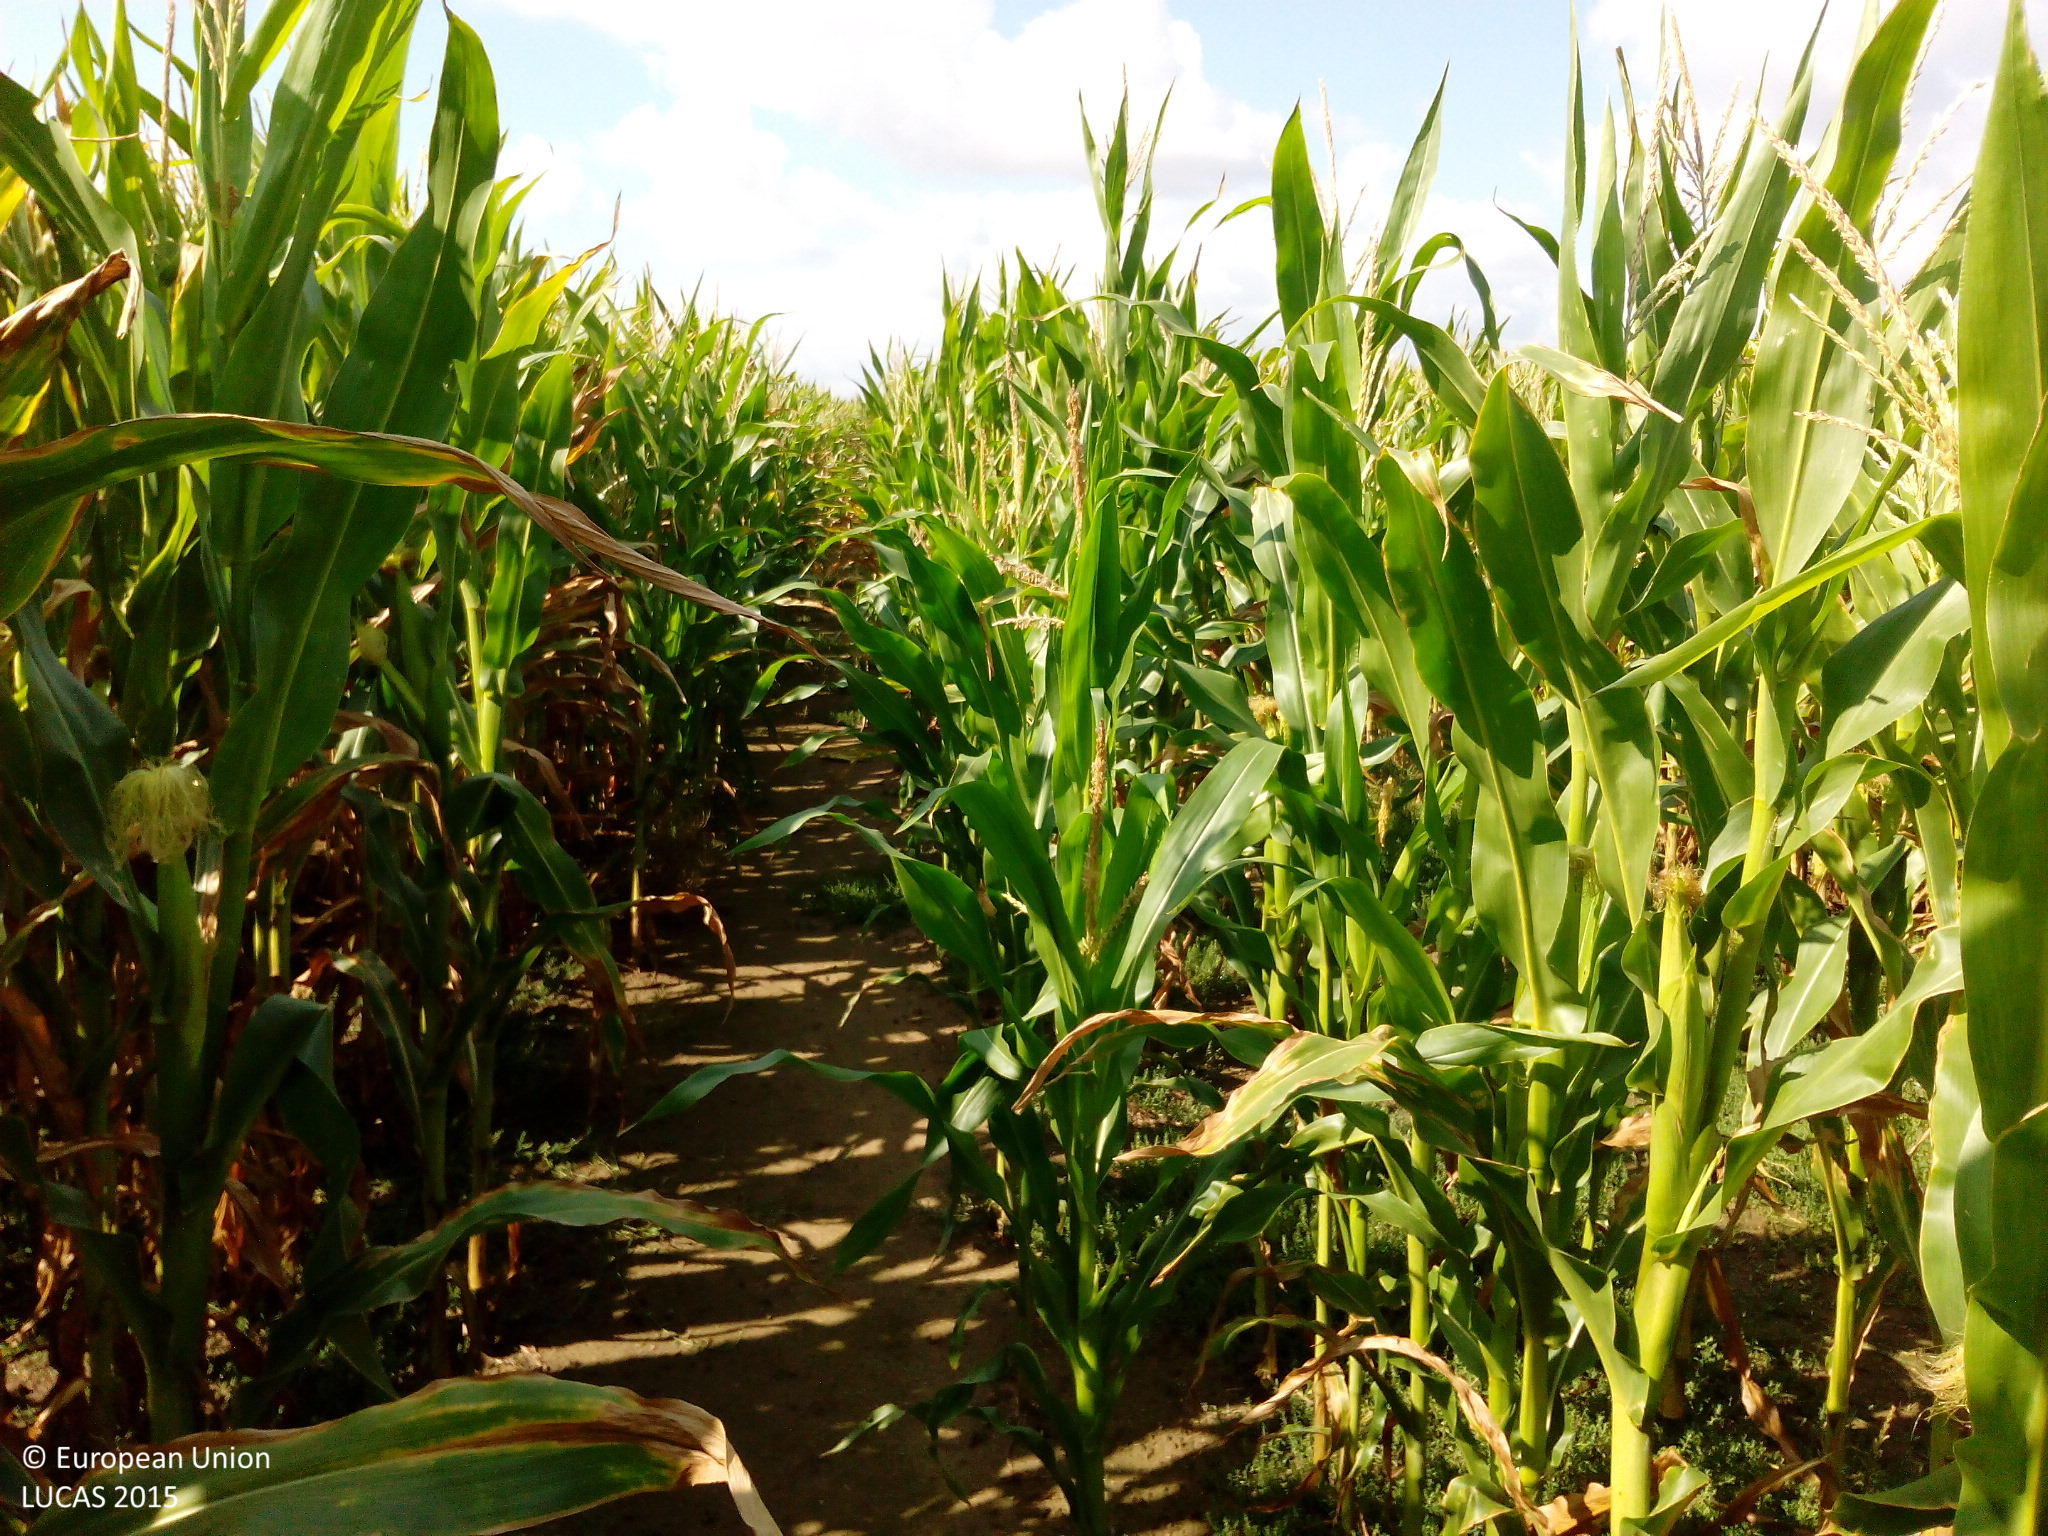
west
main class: Cropland
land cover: Maize
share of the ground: > 75 %
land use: Agriculture (excluding fallow land and kitchen gardens)
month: August
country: DE
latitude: 54.0206
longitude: 12.6396
